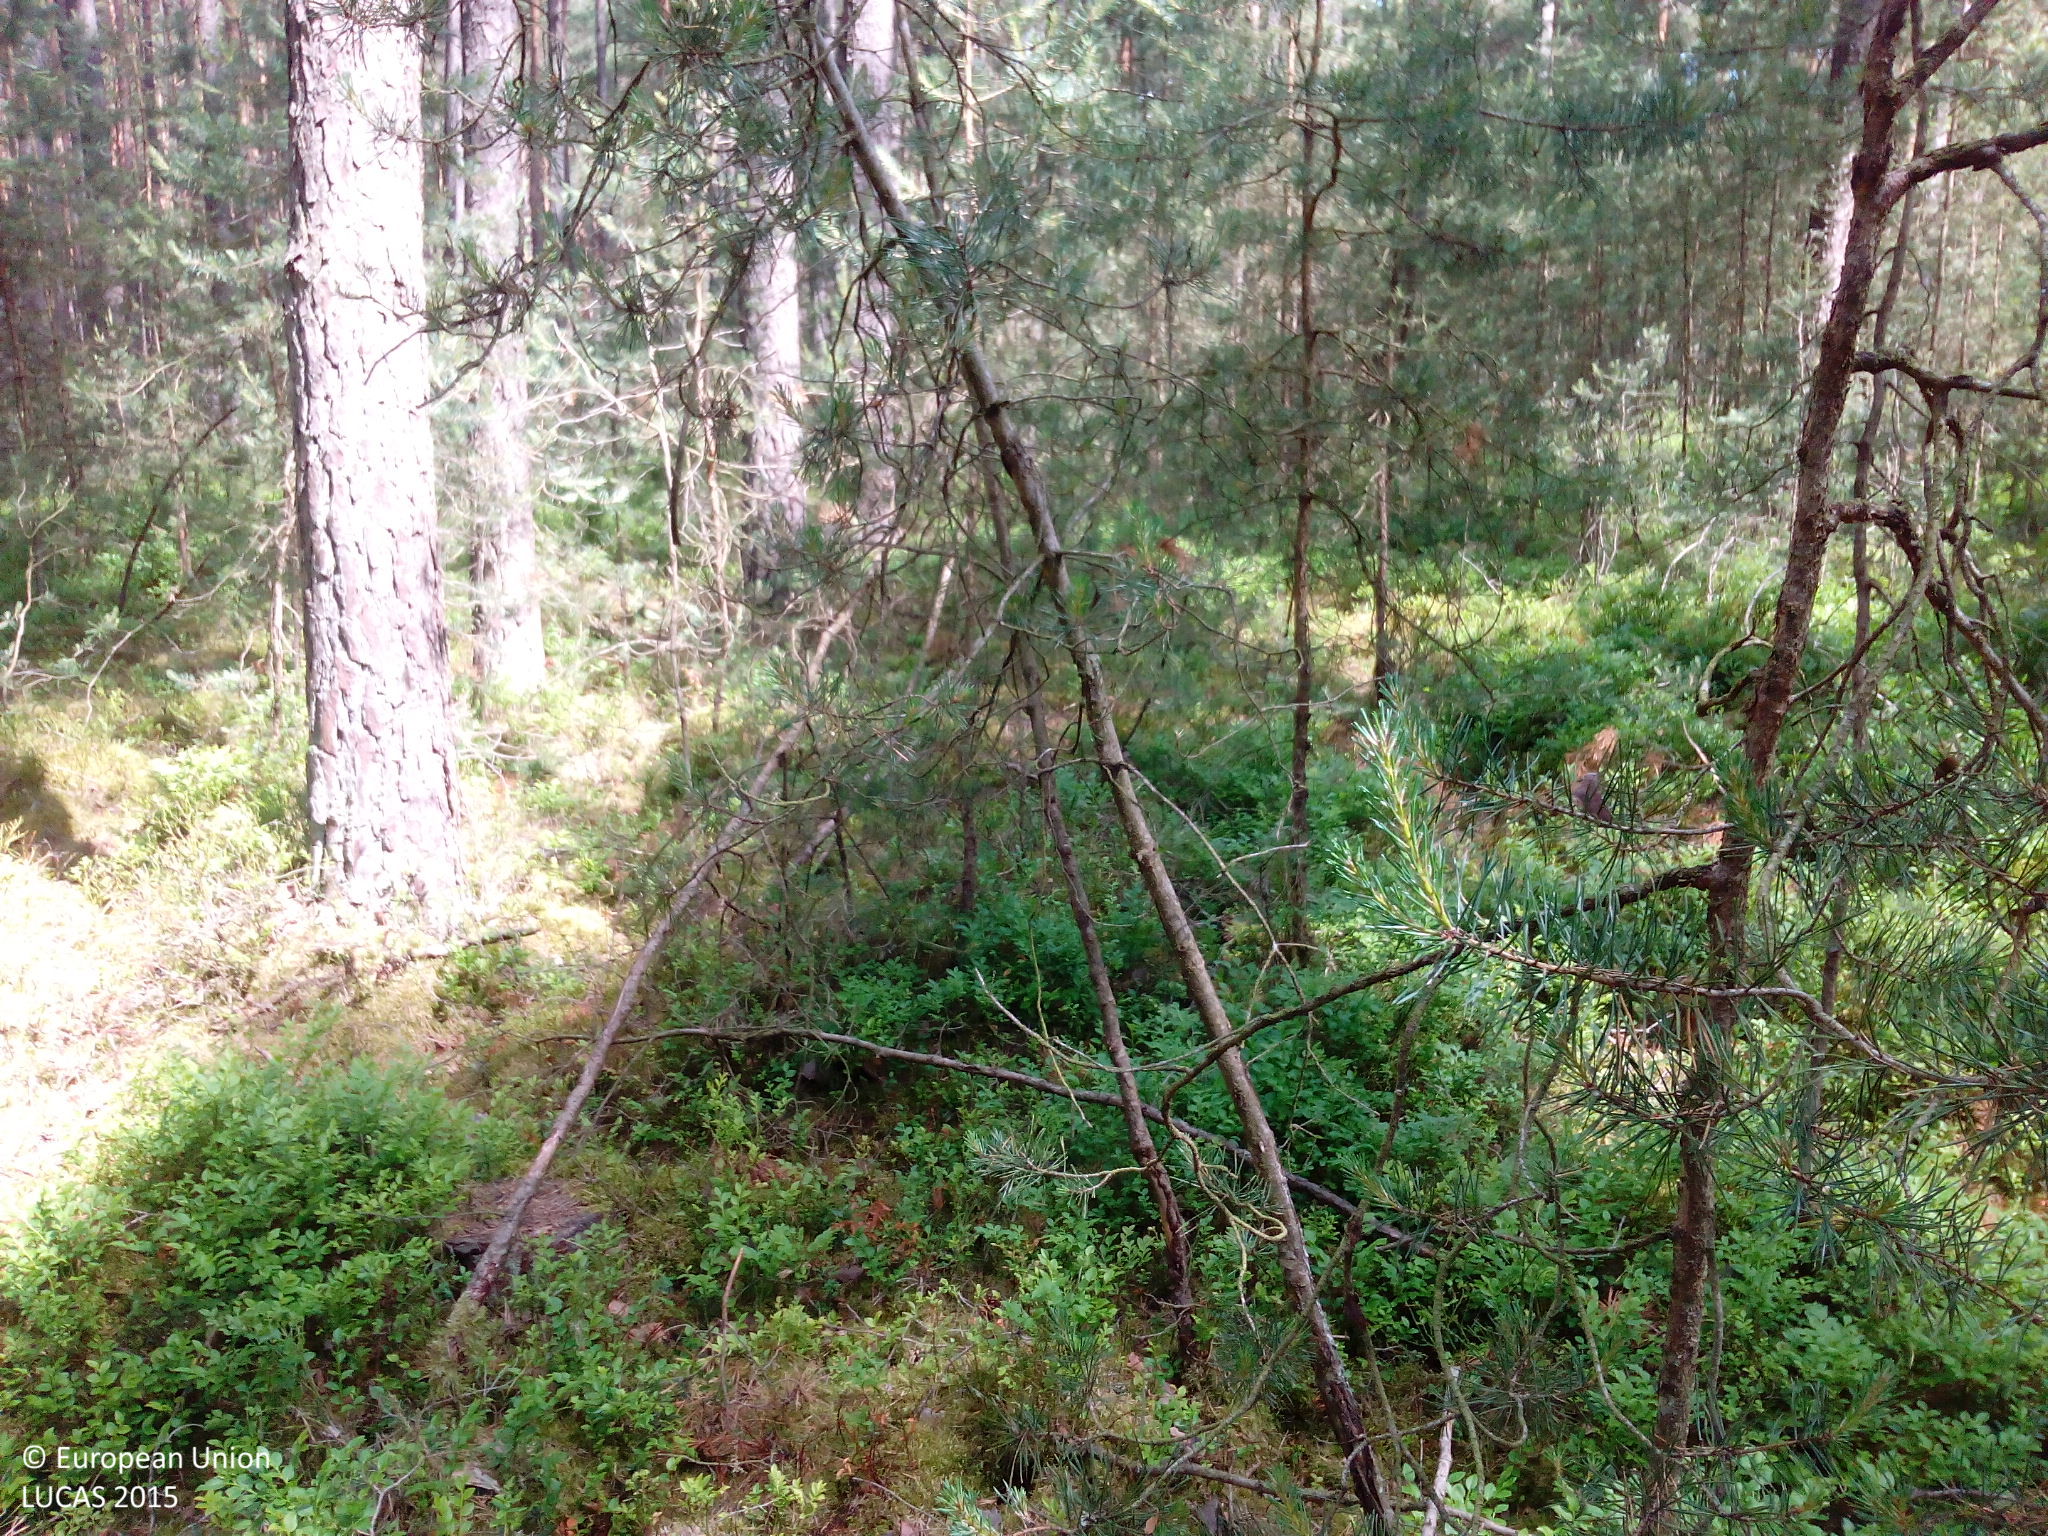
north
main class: Woodland
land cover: Pine dominated coniferous woodland
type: hemiboreal forest and nemoral coniferous forest and mixed broadleaved-coniferous forest
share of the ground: > 75 %
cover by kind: coniferous forest trees 85 %, shrubs 5 %, herbaceous plants 5 %, lichens and mosses 5 %
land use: Forestry
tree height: > 5 m
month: June
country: DE
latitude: 49.2630
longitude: 10.9478
